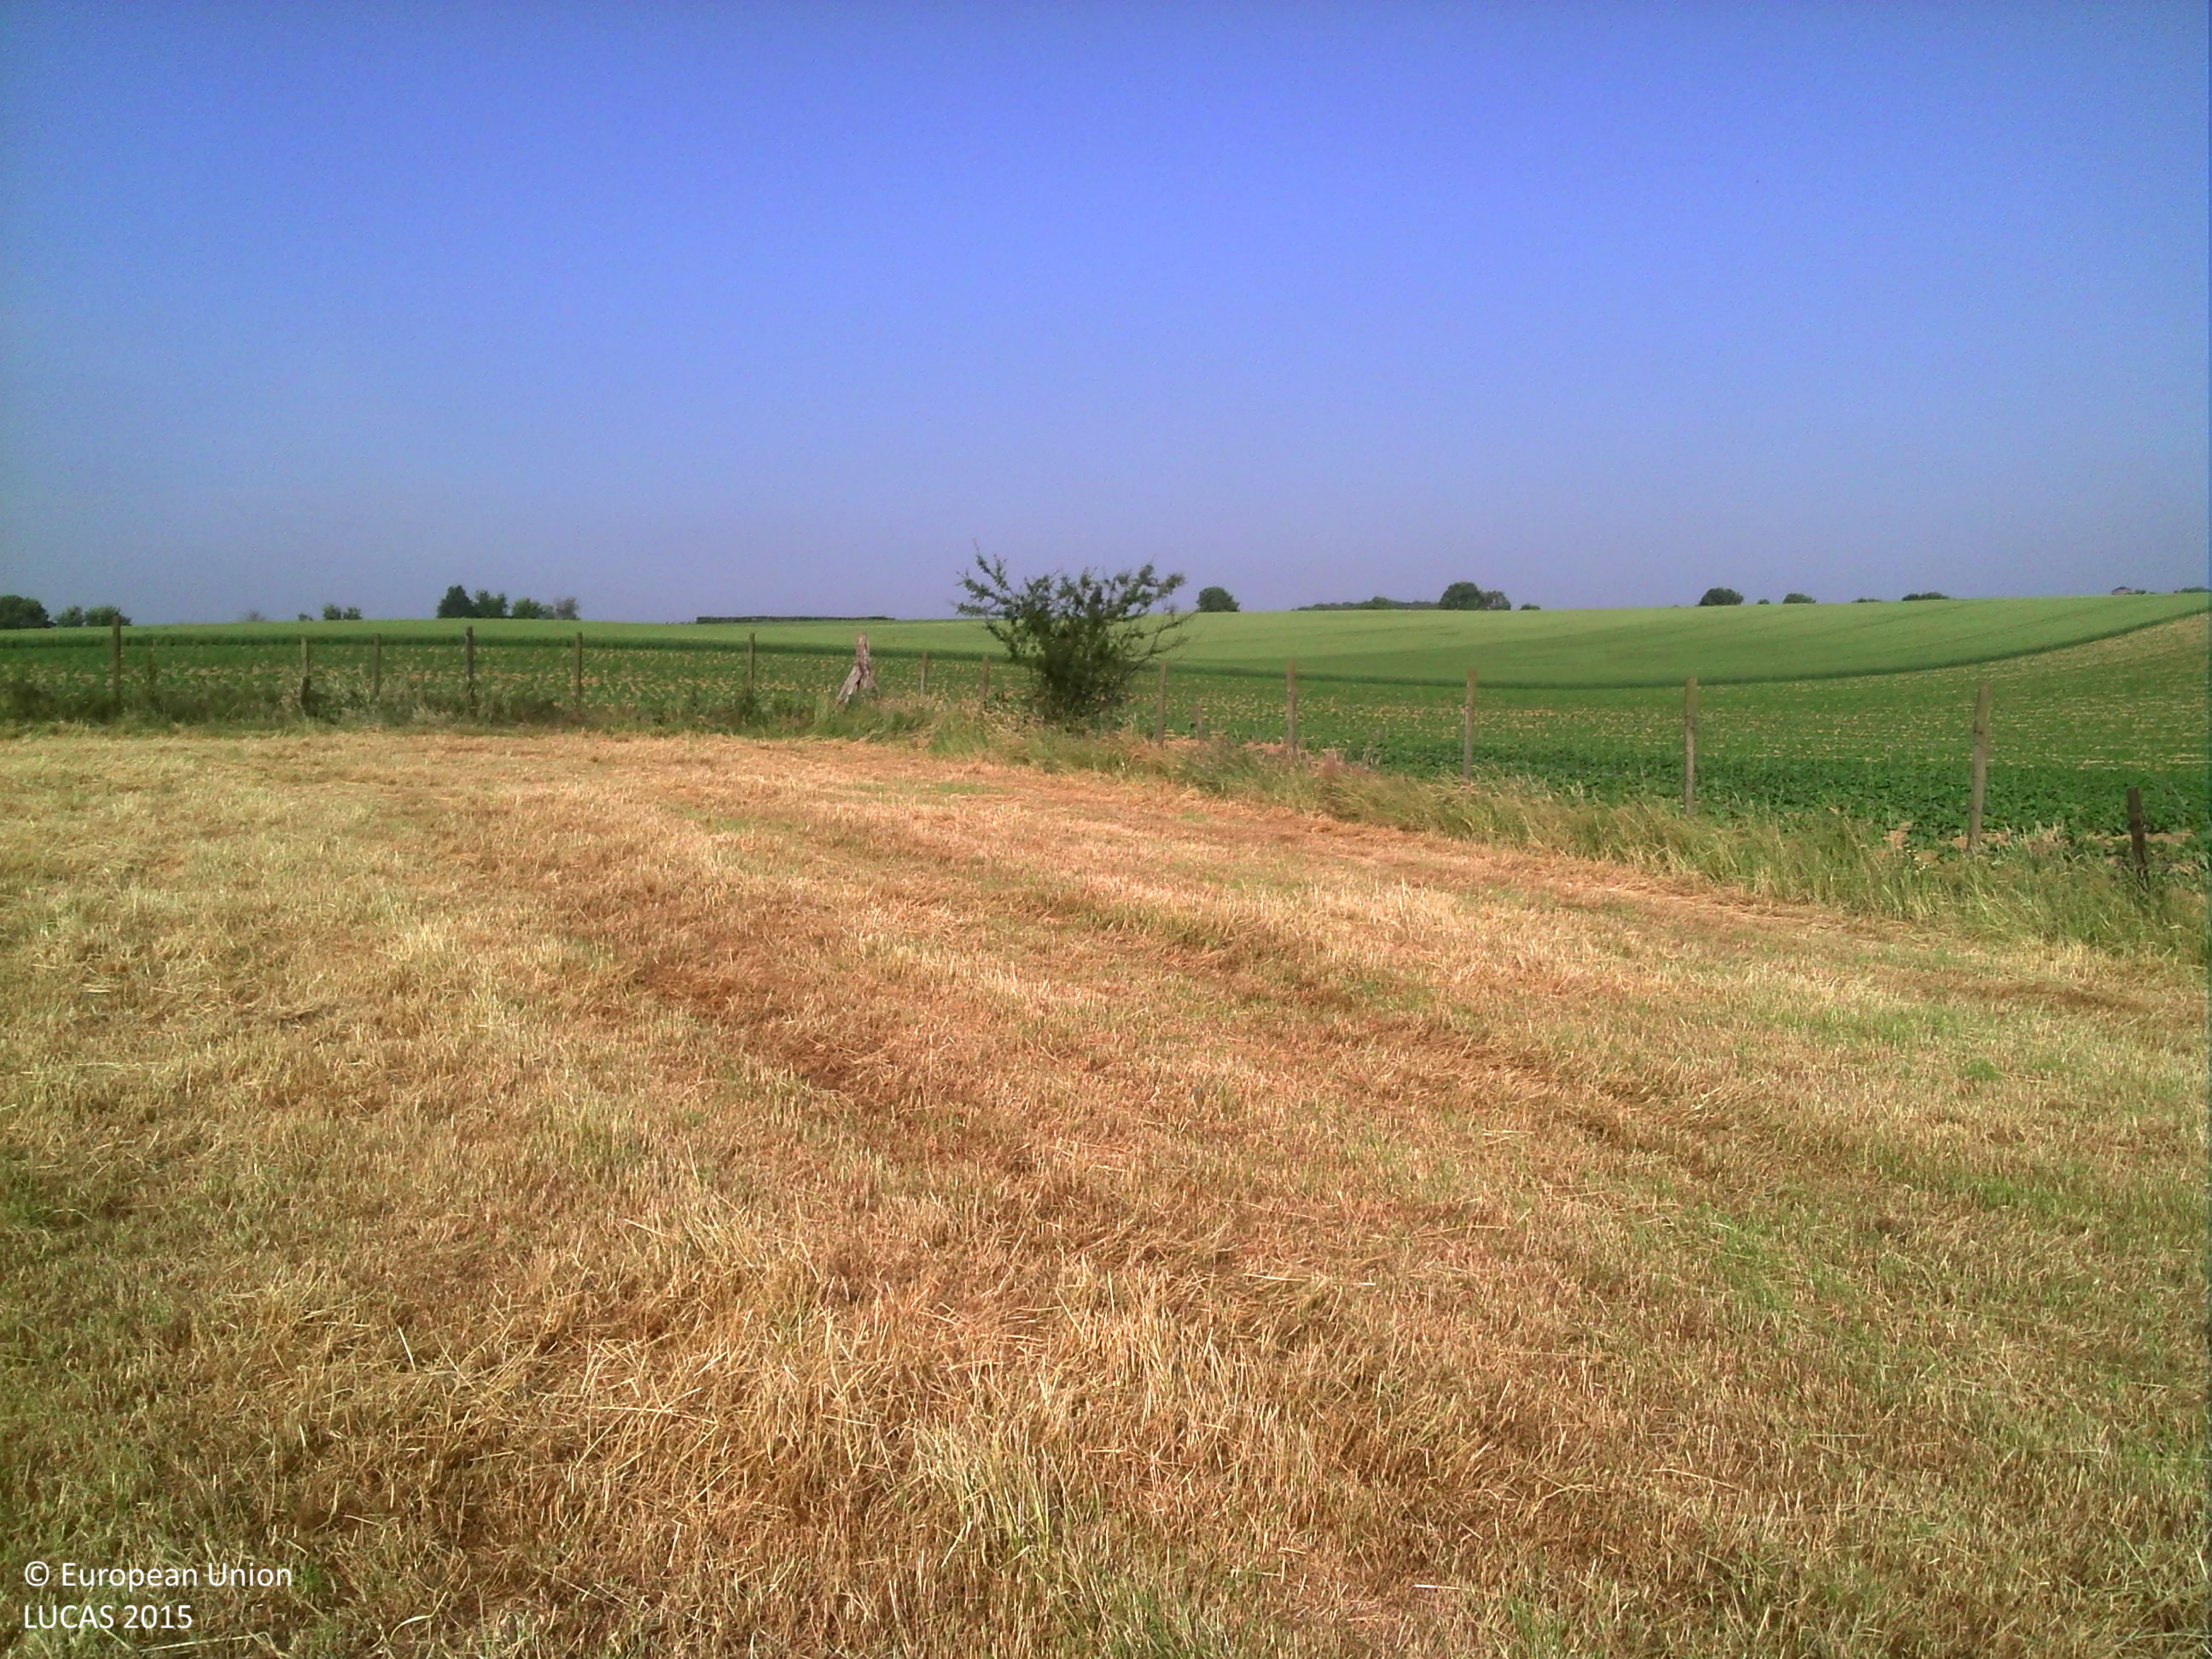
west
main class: Grassland
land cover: Grassland without tree/shrub cover
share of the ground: > 75 %
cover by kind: herbaceous plants 100 %
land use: Agriculture (excluding fallow land and kitchen gardens)
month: June
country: BE
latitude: 50.7619
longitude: 5.5040
